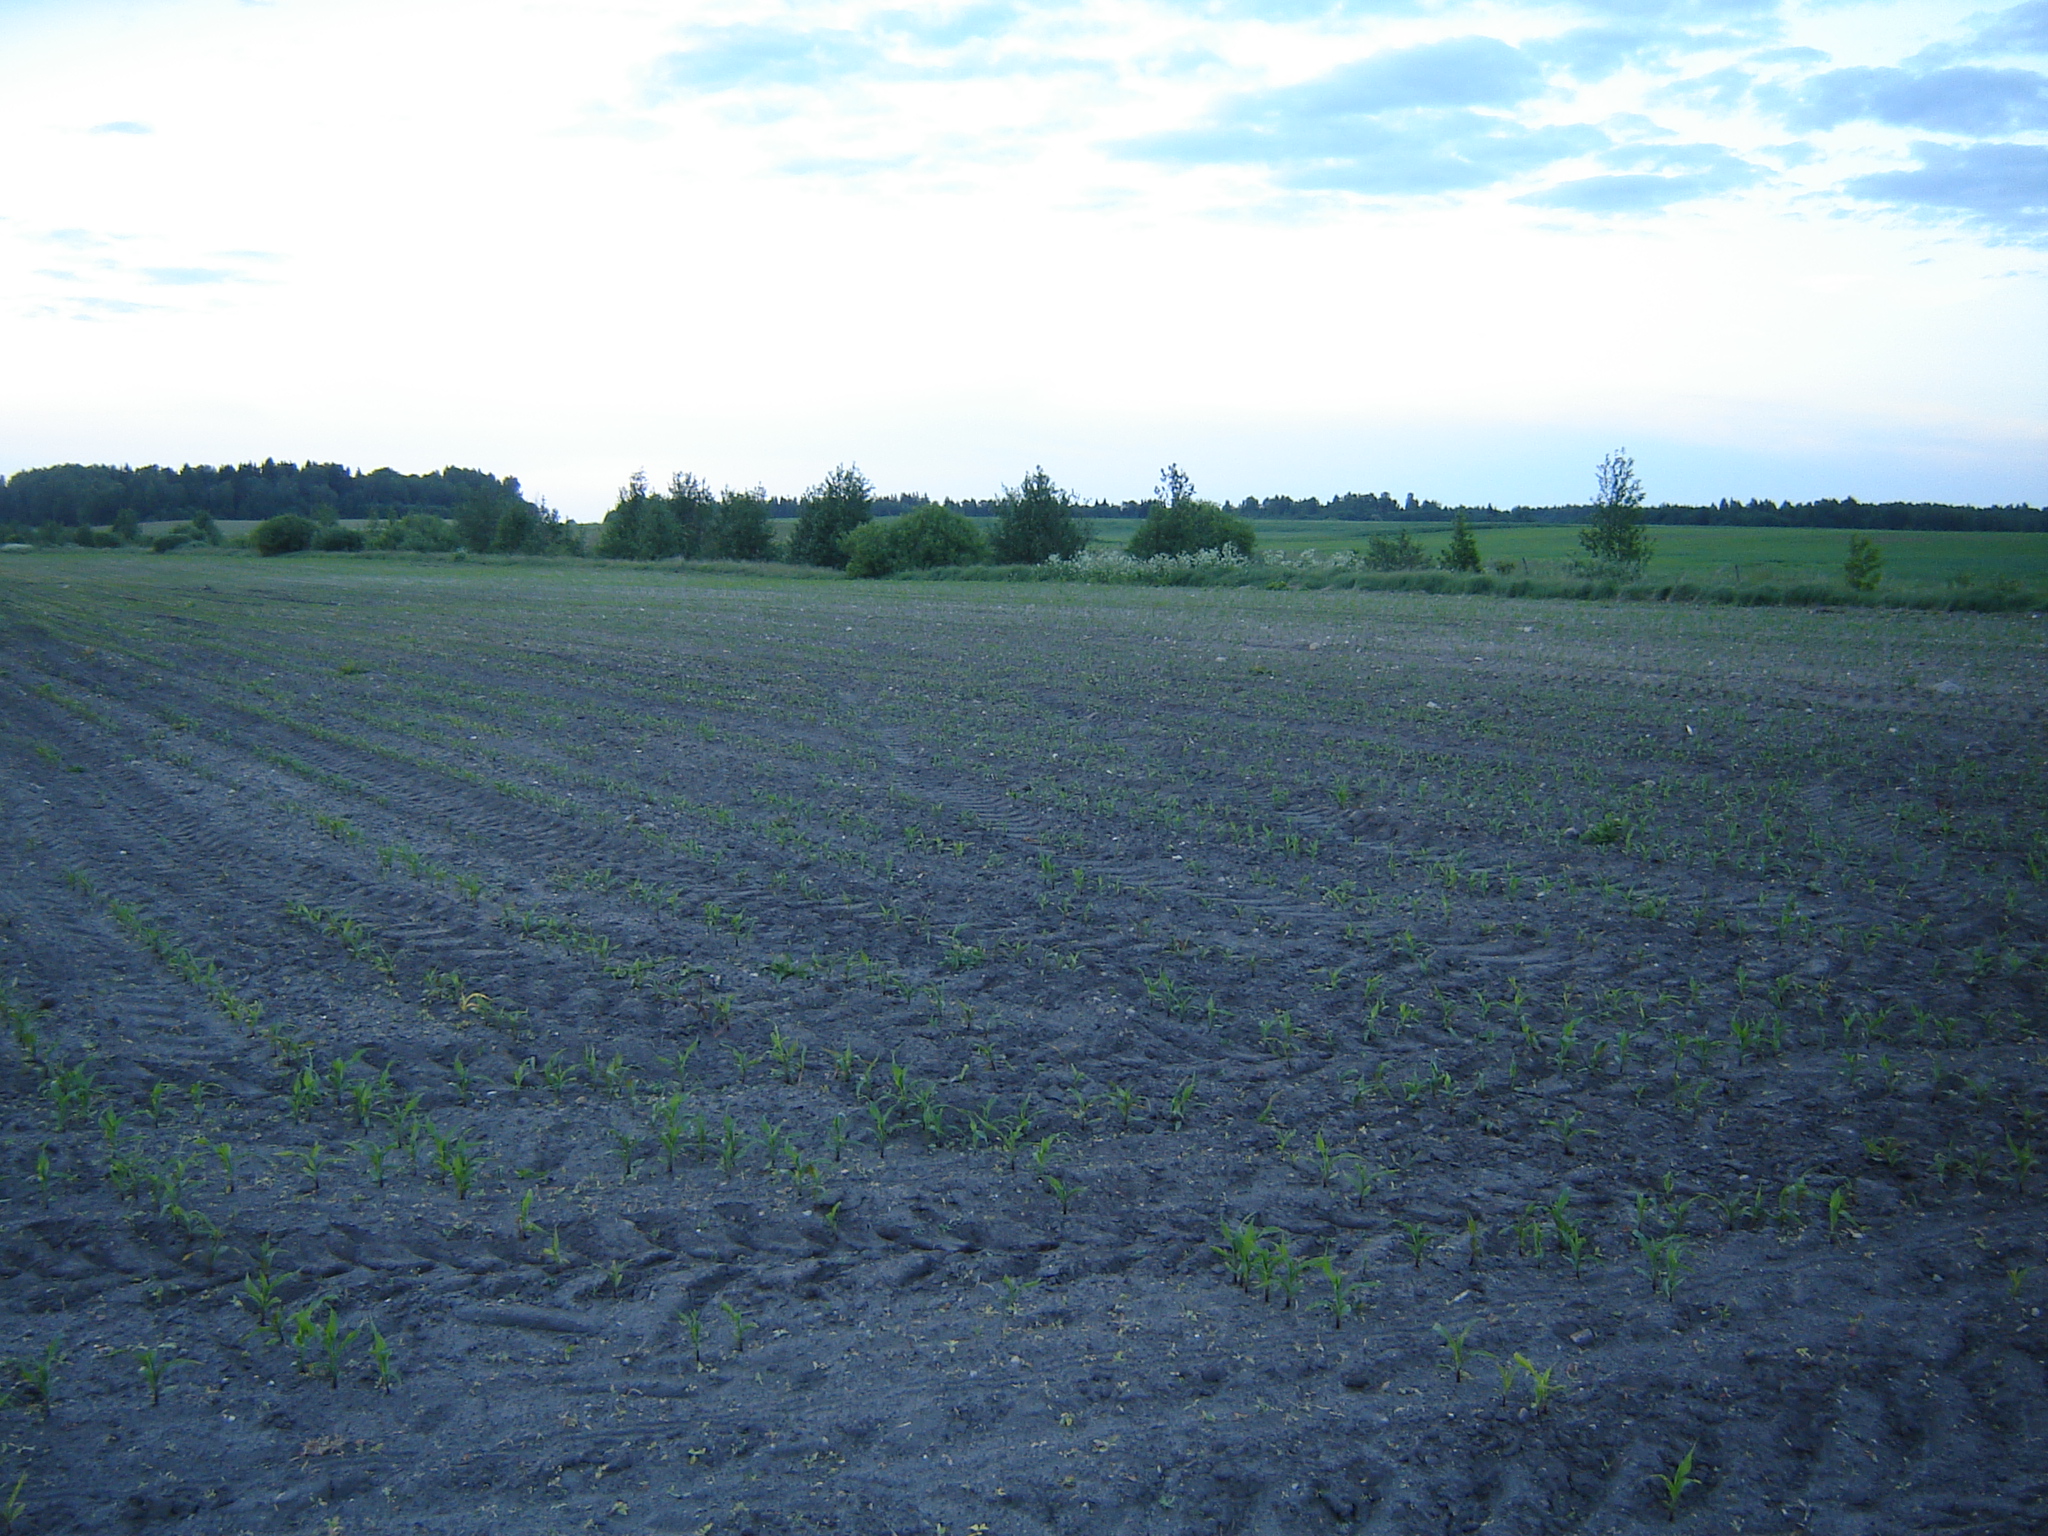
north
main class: Cropland
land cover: Maize
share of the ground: < 10 %
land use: Agriculture (excluding fallow land and kitchen gardens)
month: June
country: LT
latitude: 55.5712
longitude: 24.7112
